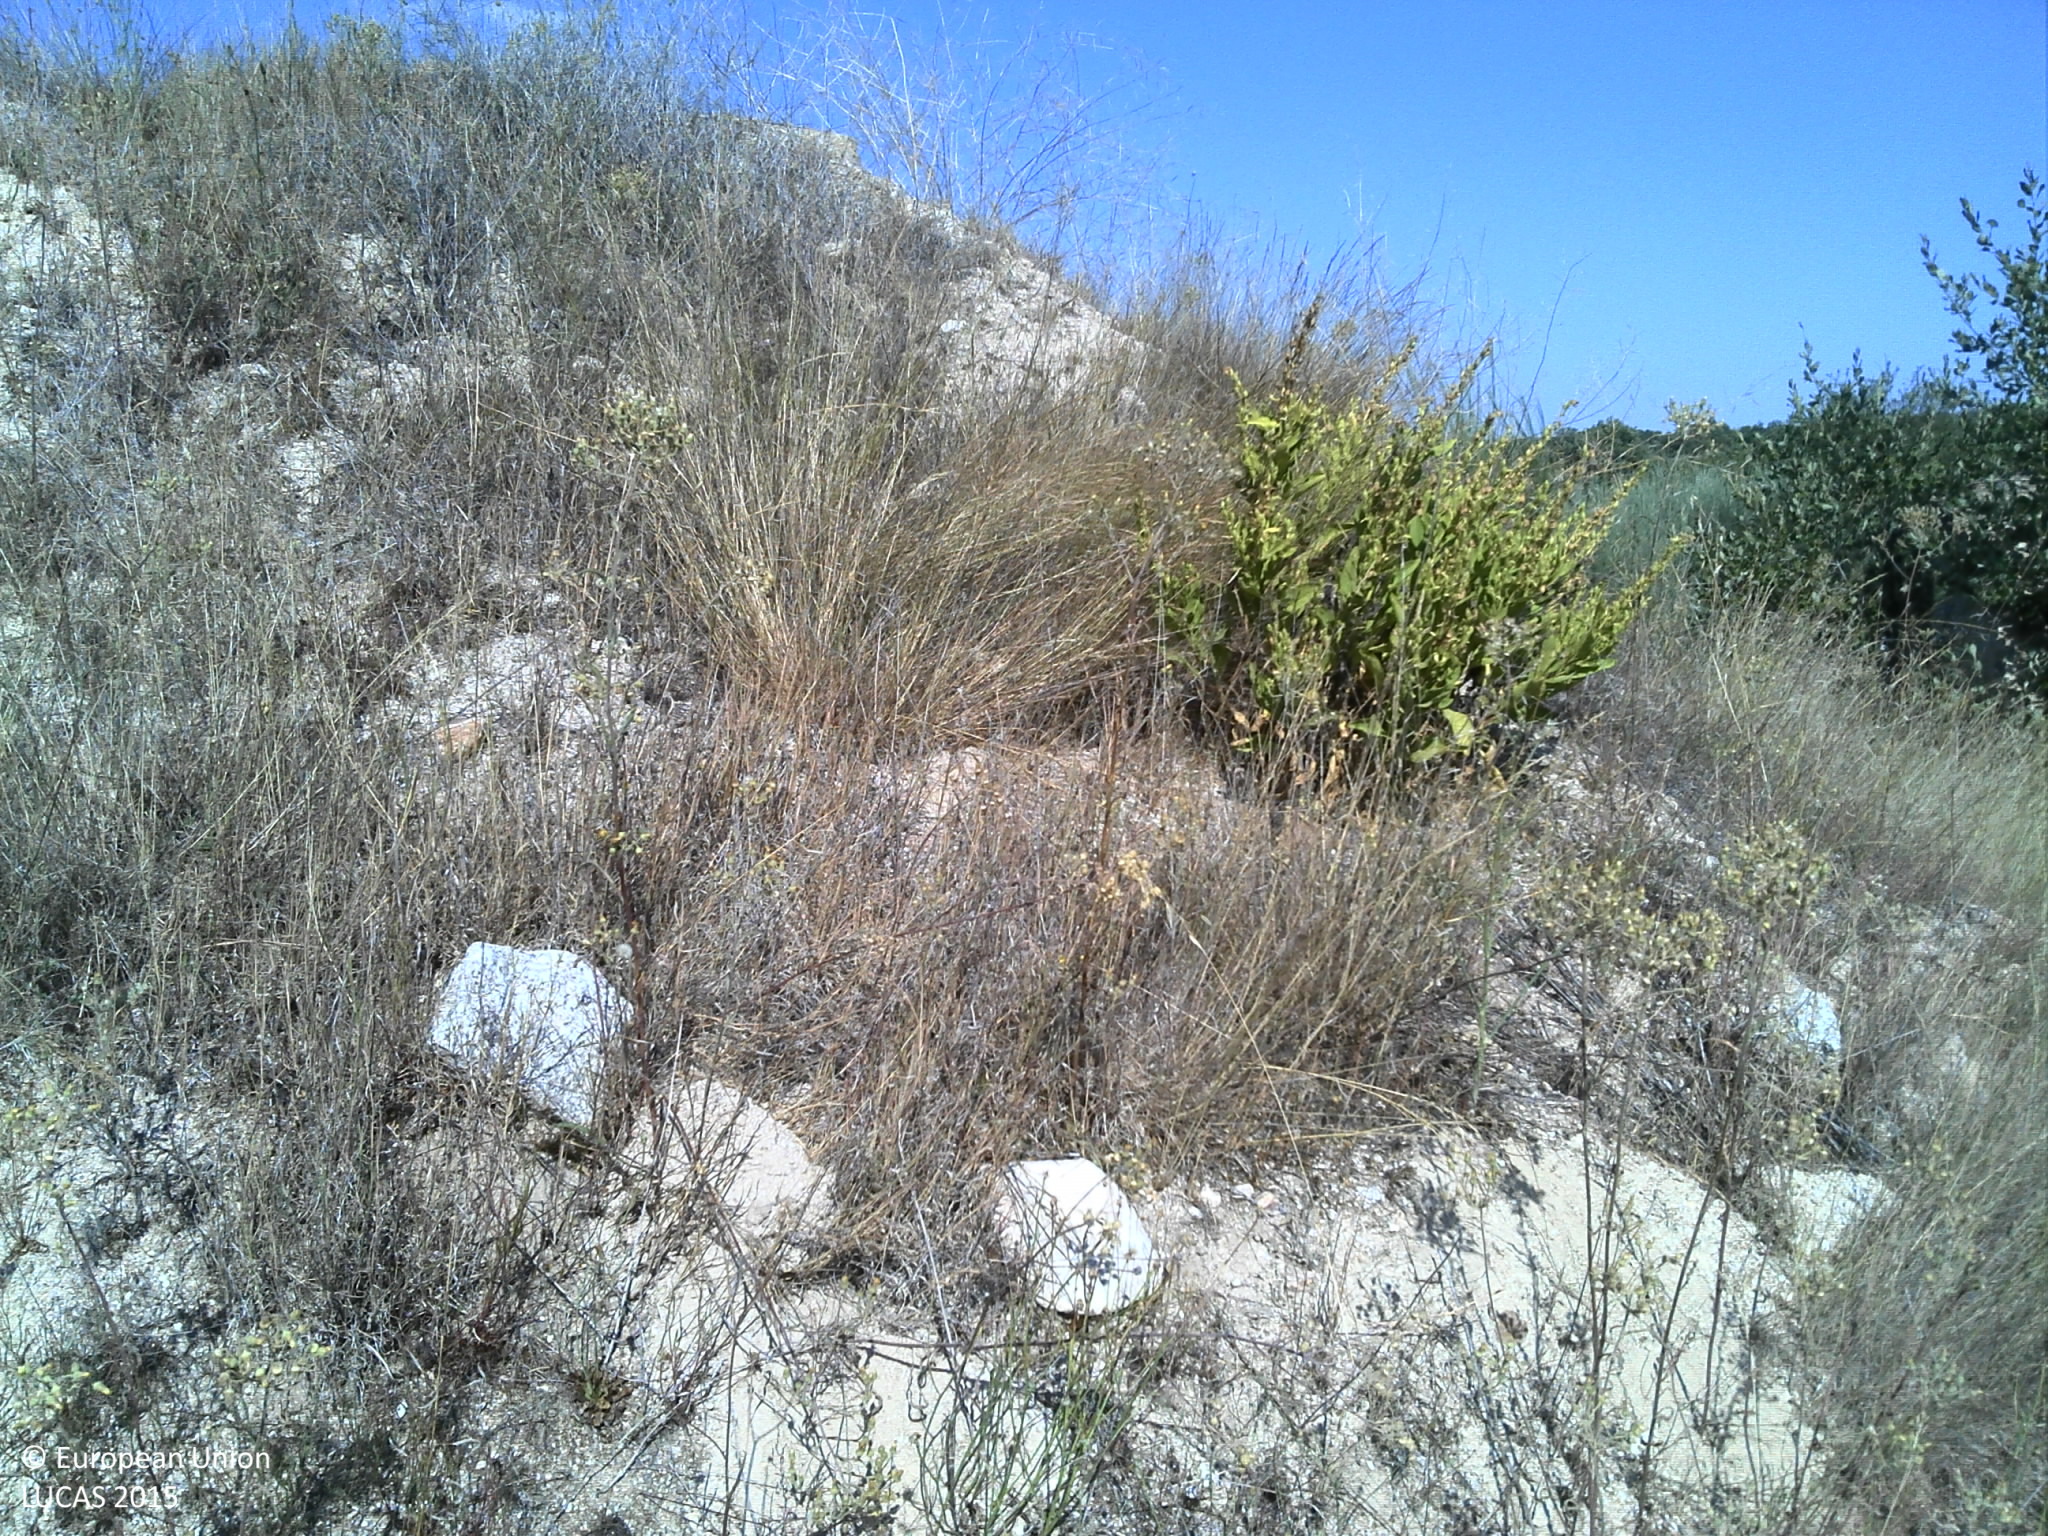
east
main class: Shrubland
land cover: Shrubland without tree cover
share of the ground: 25 - 50 %
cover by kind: unconsolidated bare surface 40 %, herbaceous plants 30 %, shrubs 25 %, consolidated bare surface 5 %
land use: Abandoned areas
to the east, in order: Shrubland without tree cover; Tracks; Electric lines; Shrubland without tree cover; Dry stone walls; Abandoned hedges; Spontaneously vegetated surfaces; Rocks and stones; Spontaneously vegetated surfaces; Dry stone walls; Abandoned hedges; Grass margins; Ditches and canals; Paved roads, cycling and walking lanes; Grass margins; Dry stone walls; Grass margins; Other bare soil; Vineyards; Dry stone walls; Ditches and canals; Abandoned hedges; Other bare soil; Shrubland with sparse tree cover
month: June
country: PT
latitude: 40.7677
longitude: -6.8634
